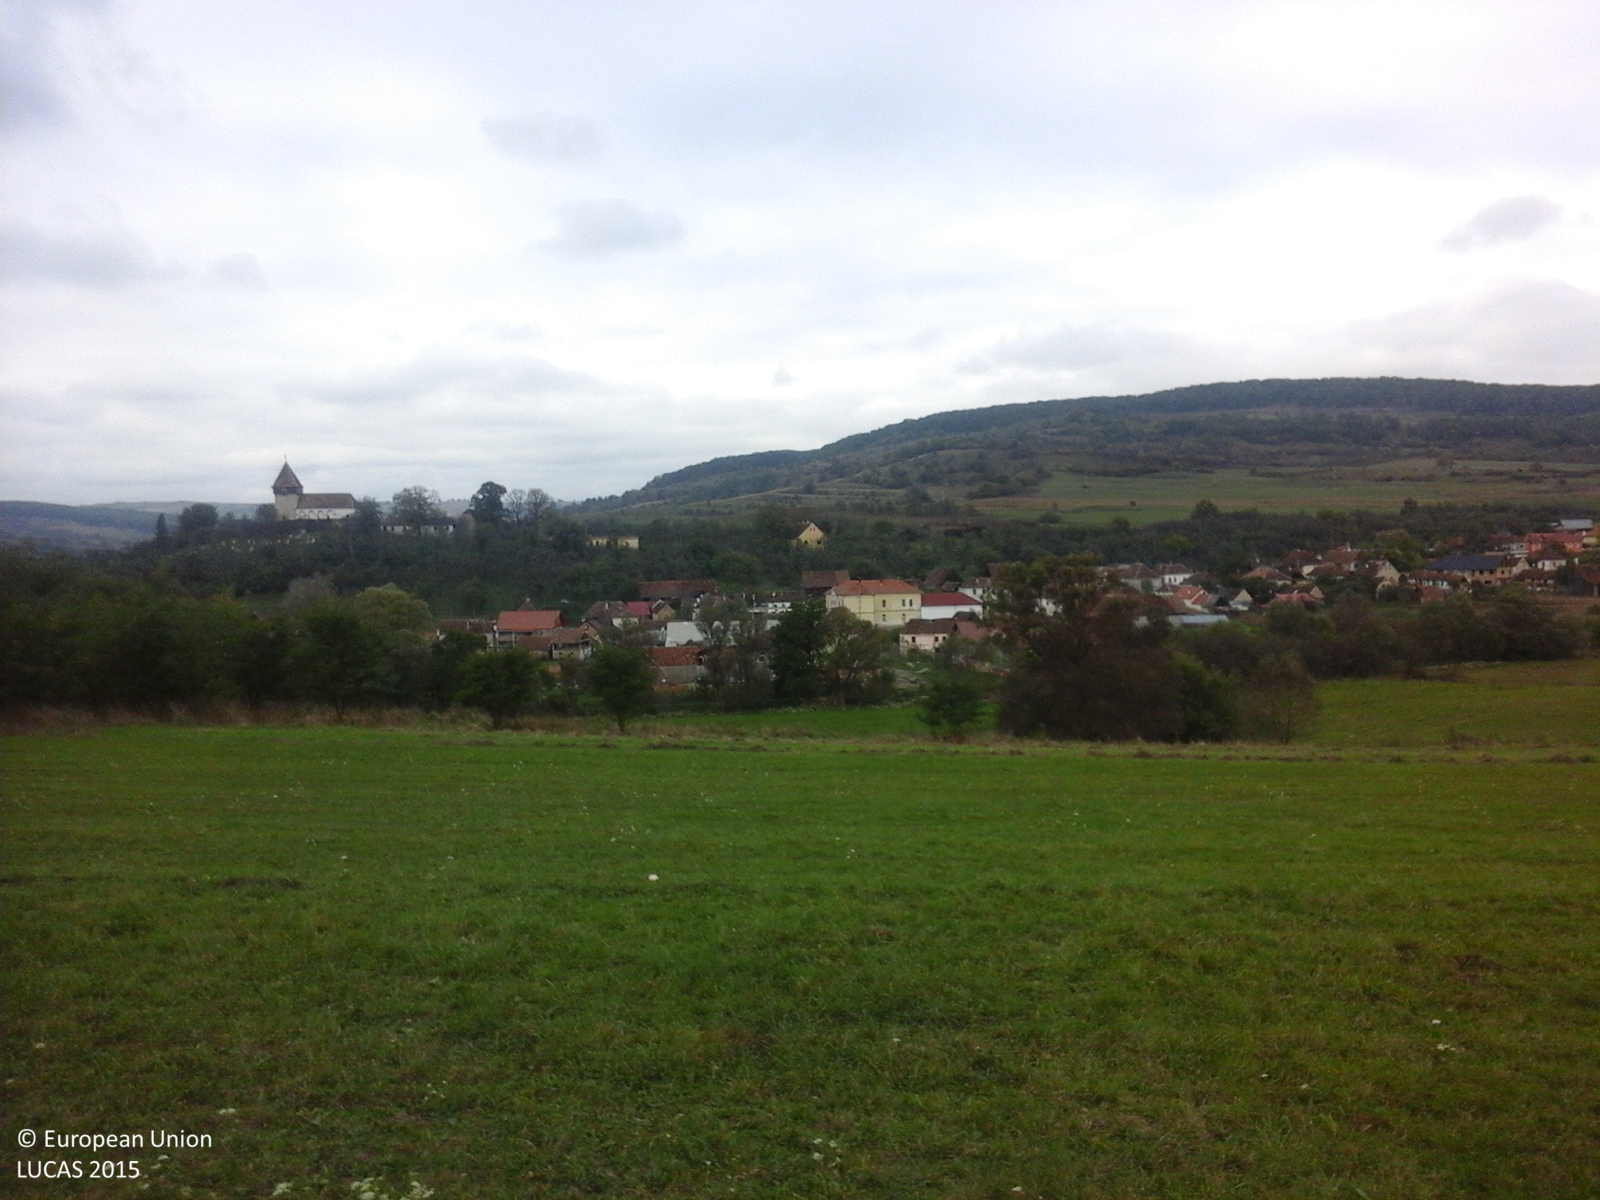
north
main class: Grassland
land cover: Grassland without tree/shrub cover
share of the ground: > 75 %
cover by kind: herbaceous plants 100 %
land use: Agriculture (excluding fallow land and kitchen gardens)
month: October
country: RO
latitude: 45.9077
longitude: 24.8763
